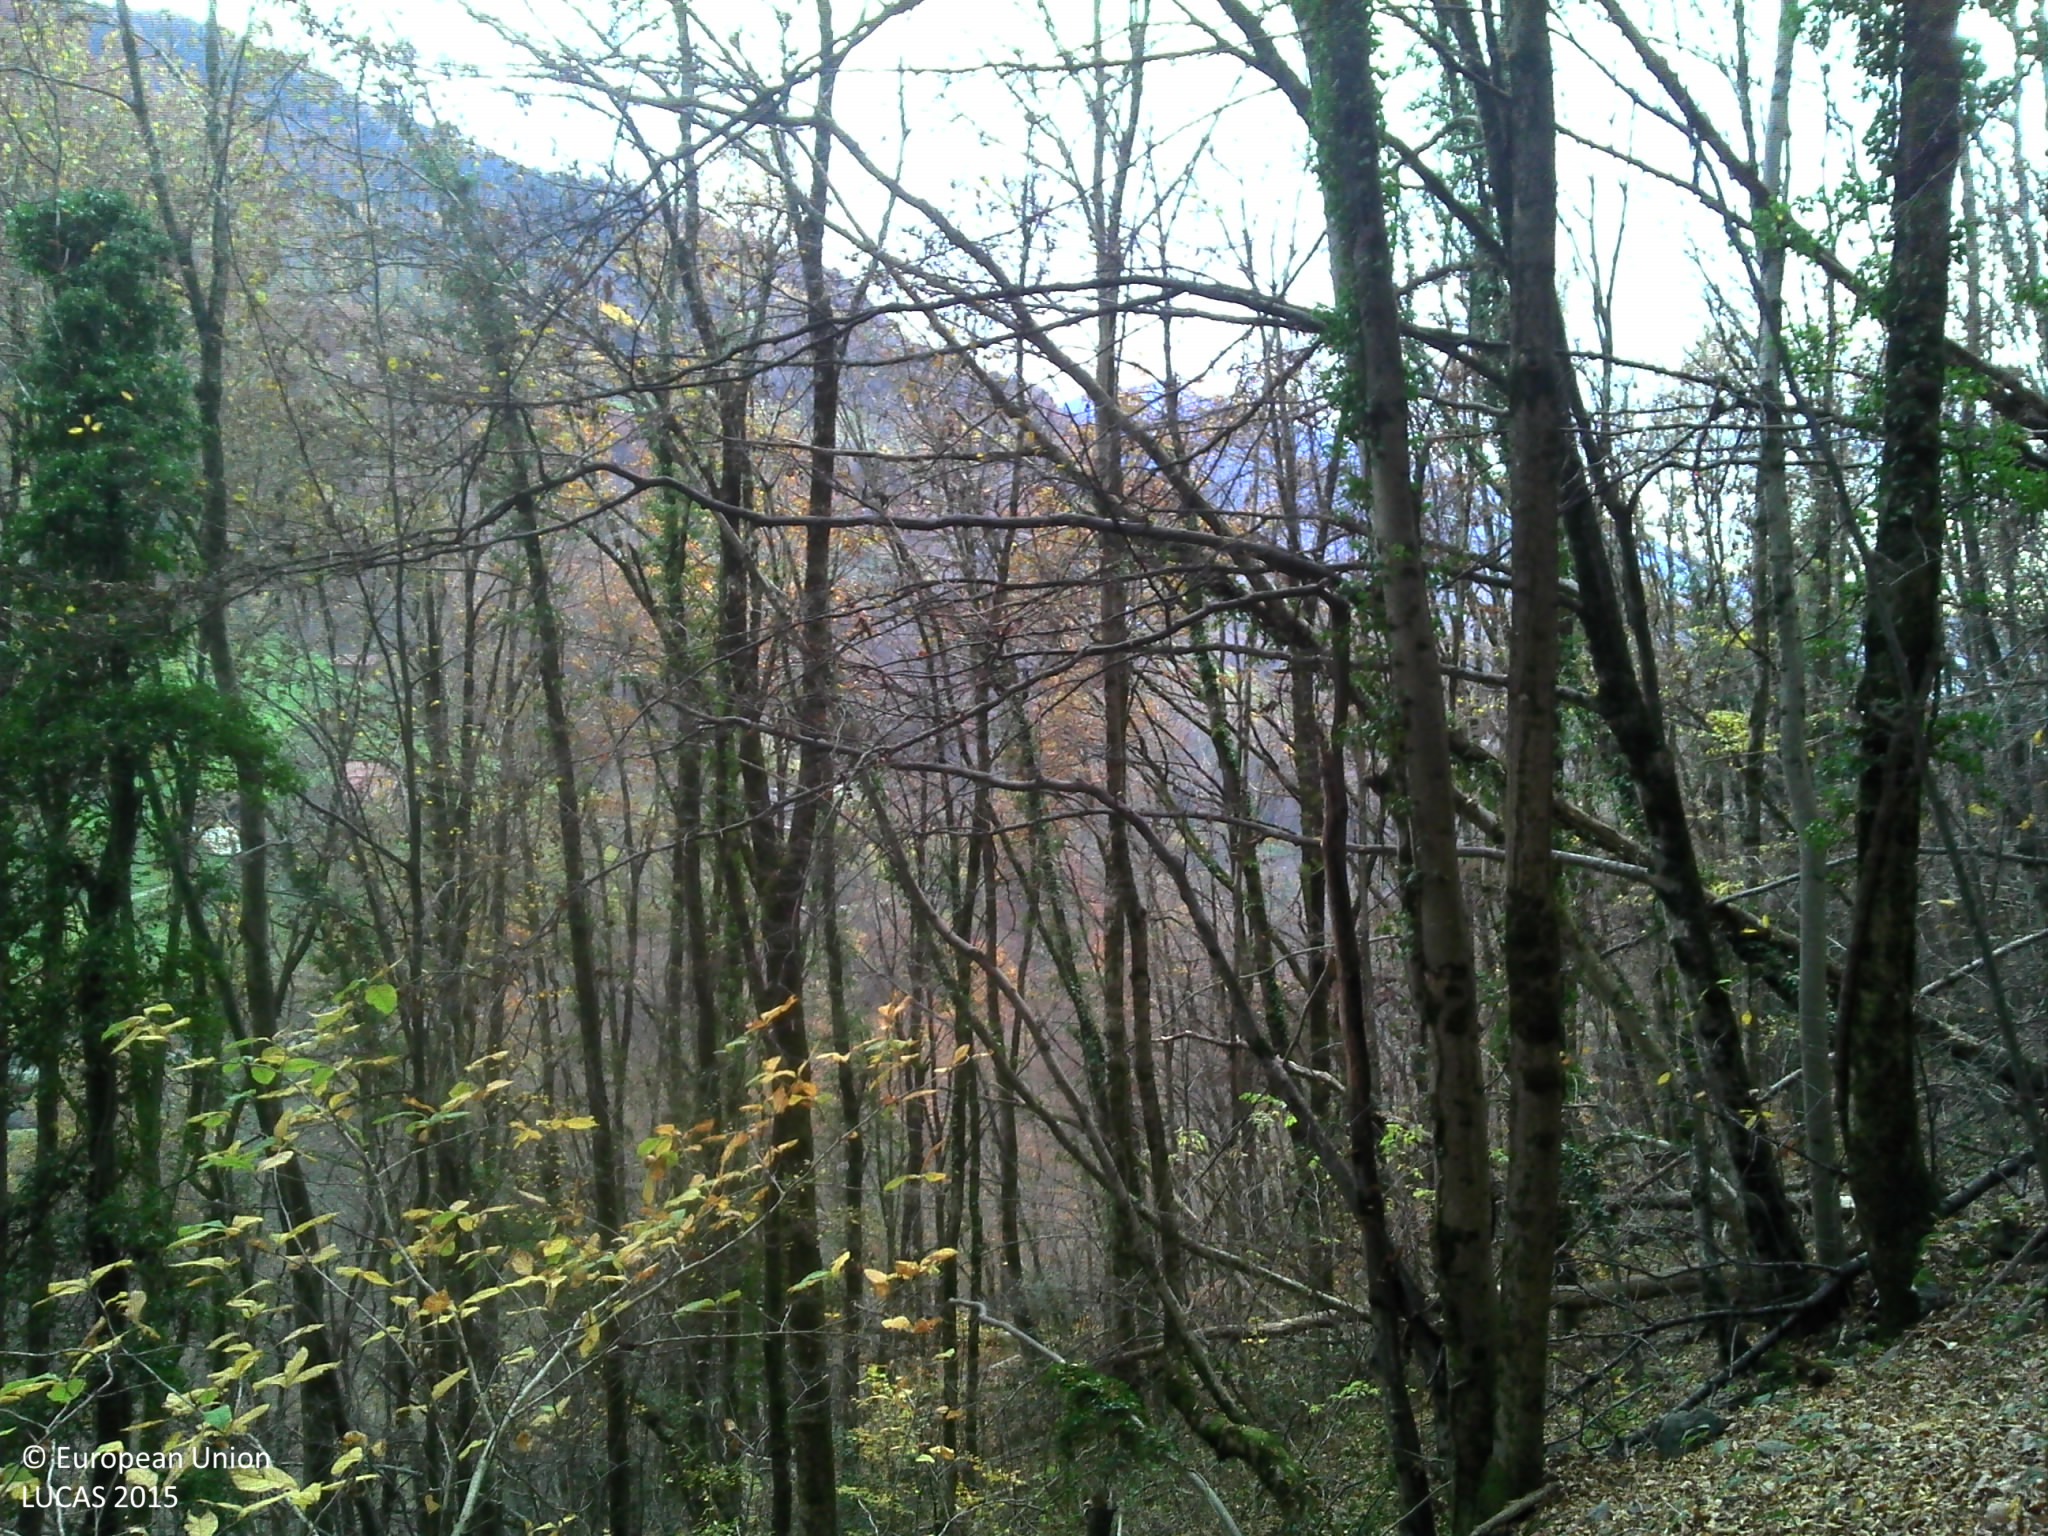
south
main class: Woodland
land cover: Broadleaved woodland
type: mesophytic deciduous forest
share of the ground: > 75 %
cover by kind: broadleaved forest trees 90 %, shrubs 5 %, unconsolidated bare surface 5 %
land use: Forestry
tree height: > 5 m
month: November
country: FR
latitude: 45.6963
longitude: 6.4213
